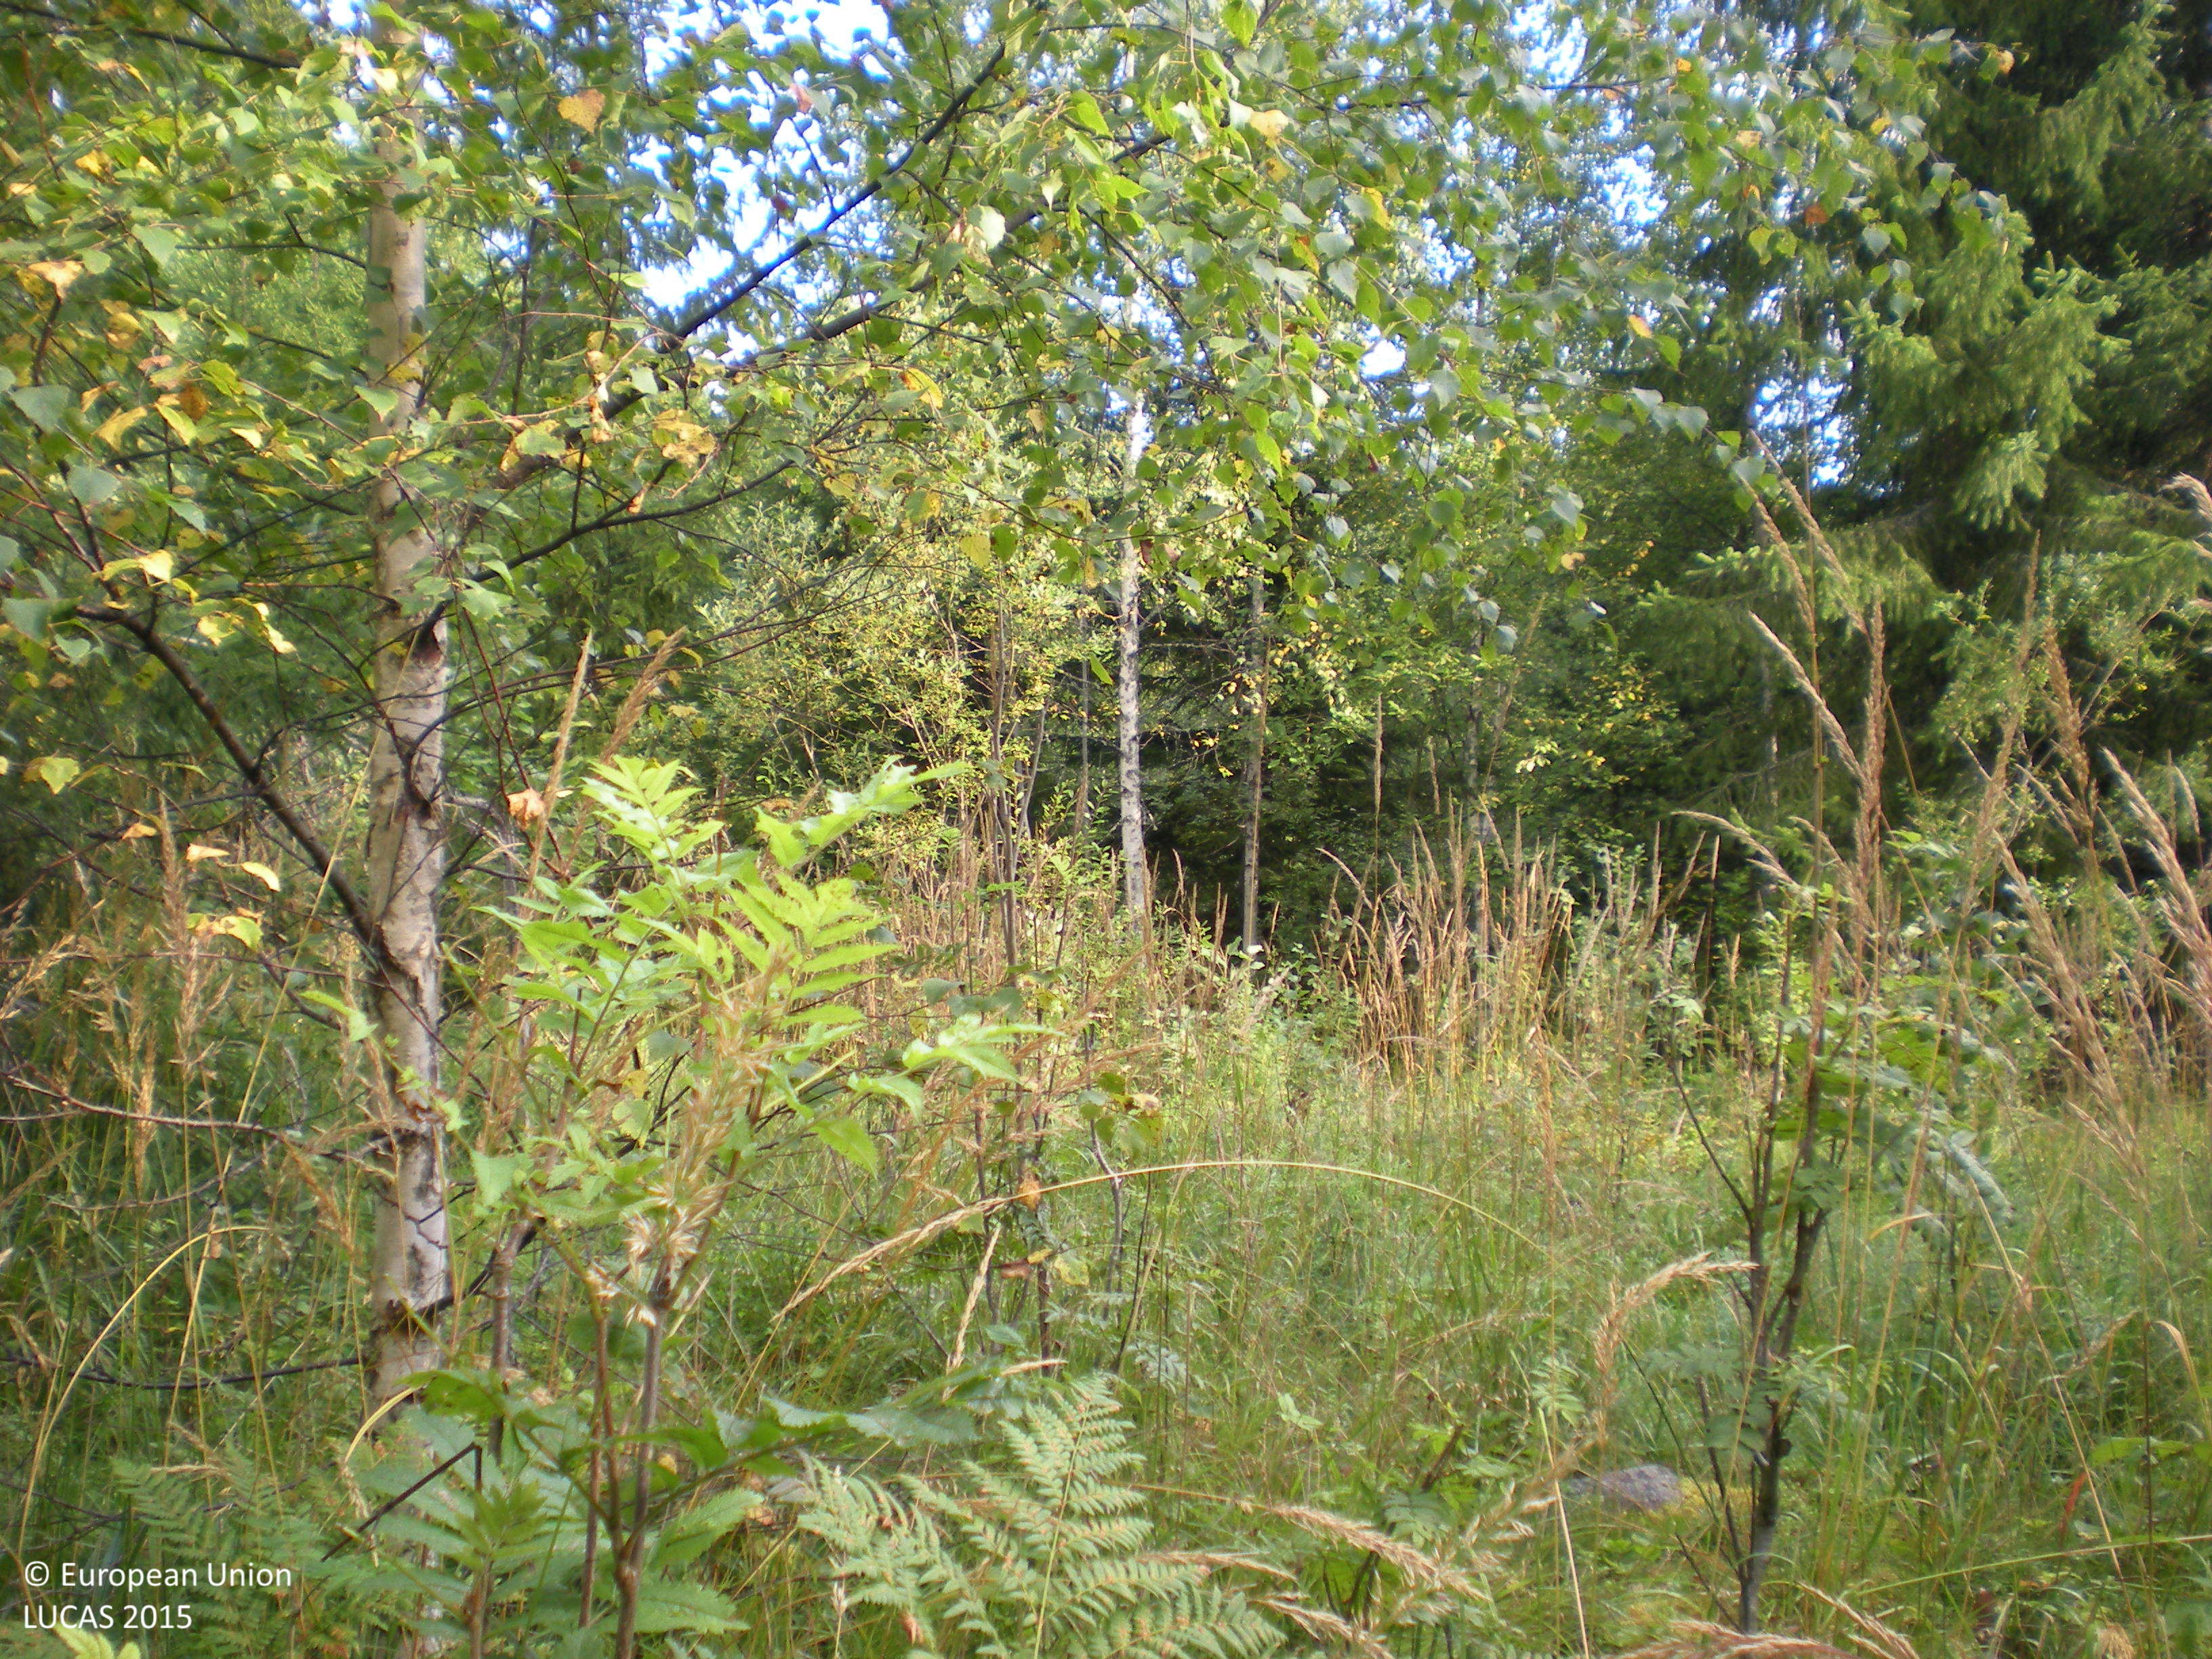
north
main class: Woodland
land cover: Spruce dominated mixed woodland
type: boreal forest
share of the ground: 50 - 75 %
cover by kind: herbaceous plants 35 %, coniferous forest trees 30 %, broadleaved forest trees 25 %, shrubs 5 %, lichens and mosses 5 %
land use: Forestry
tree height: > 5 m
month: August
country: SE
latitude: 60.4522
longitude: 17.1343
